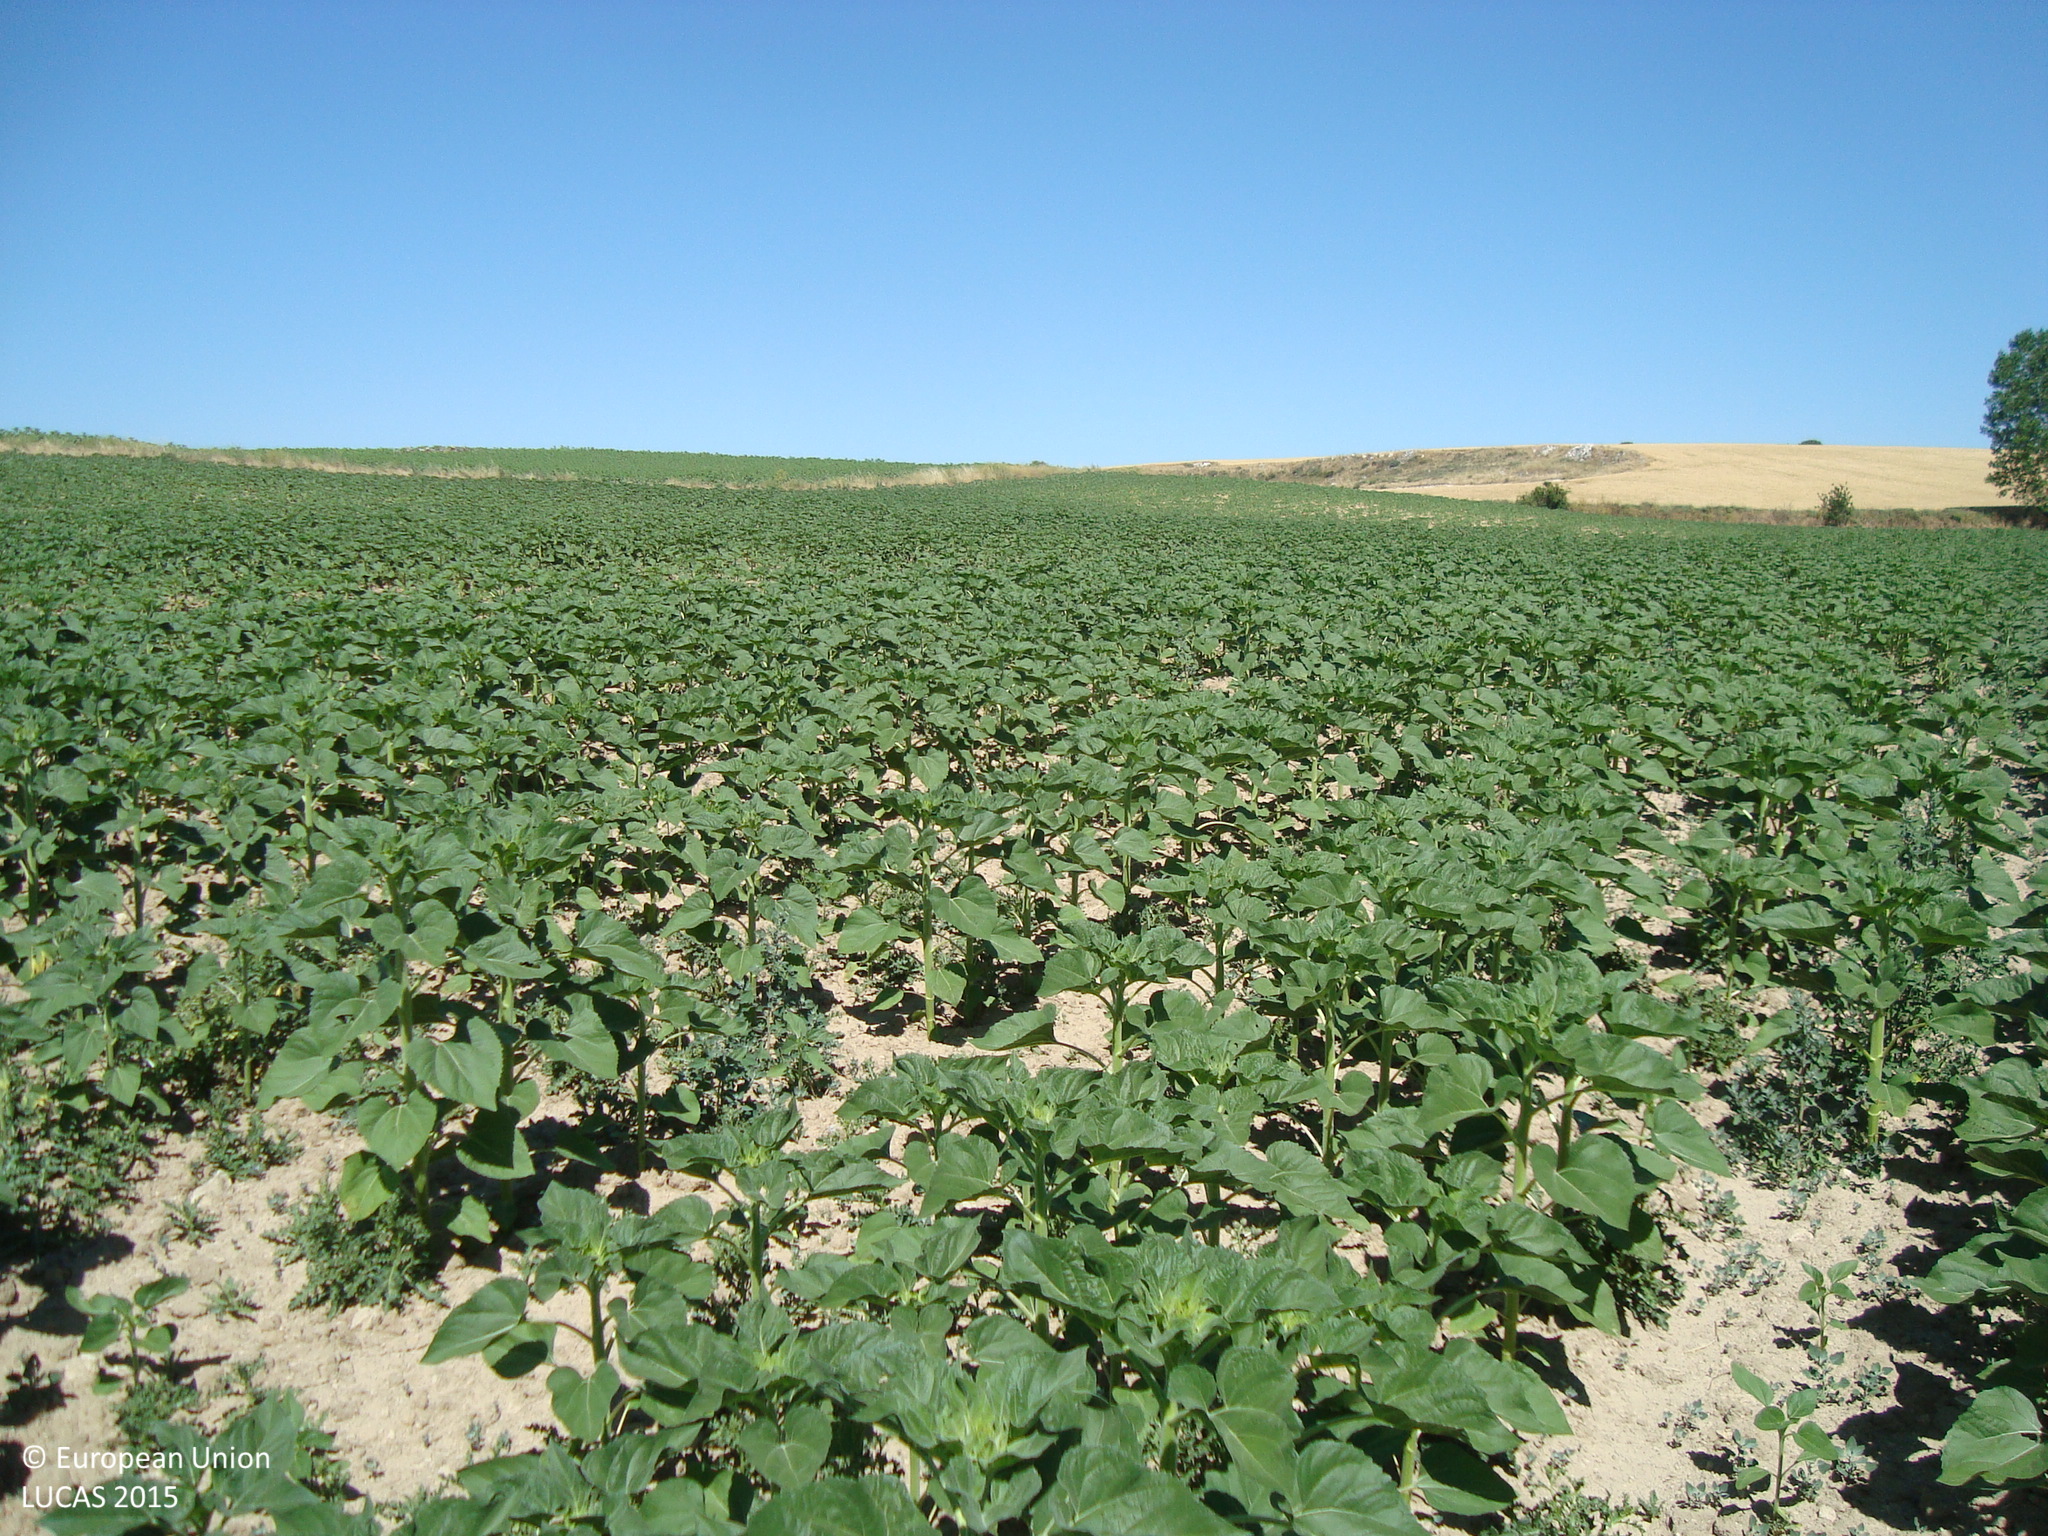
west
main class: Cropland
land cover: Sunflower
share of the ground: 50 - 75 %
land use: Agriculture (excluding fallow land and kitchen gardens)
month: July
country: ES
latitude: 41.6657
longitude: -4.0744
